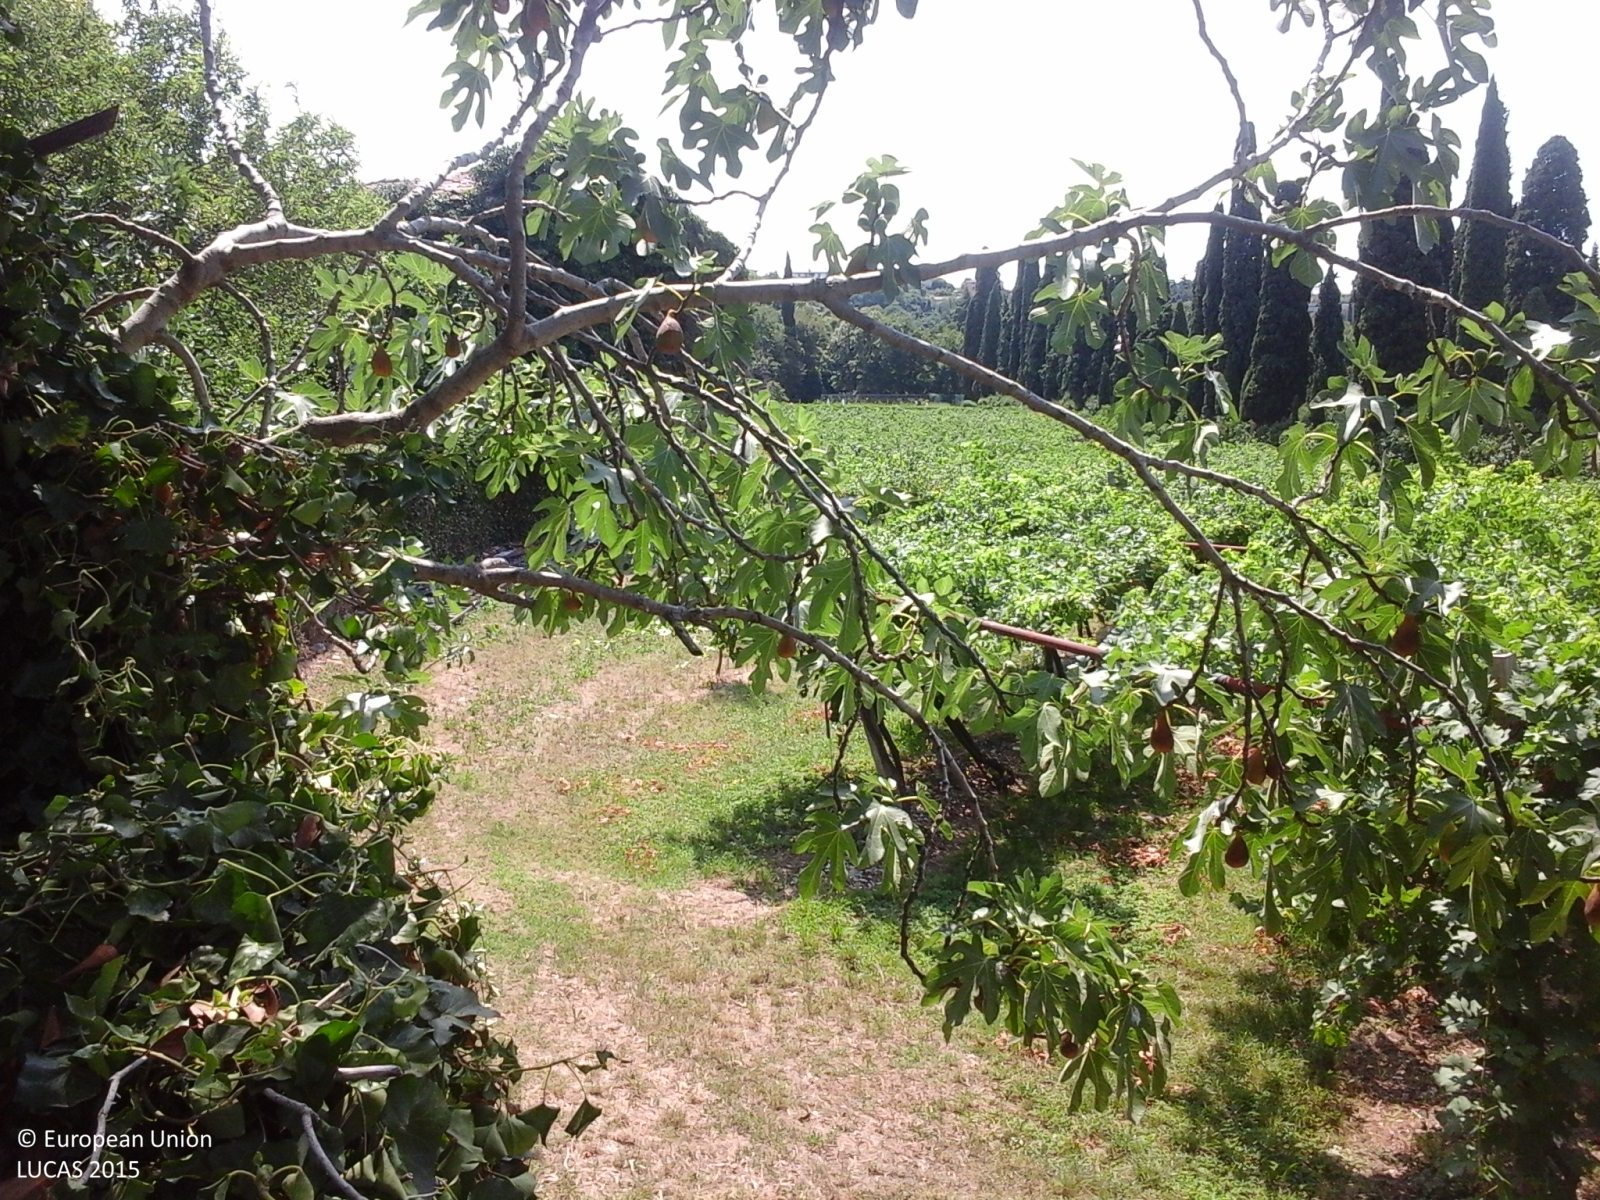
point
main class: Cropland
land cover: Vineyards
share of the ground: > 75 %
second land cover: Grassland without tree/shrub cover
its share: > 75 %
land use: Agriculture (excluding fallow land and kitchen gardens)
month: July
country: IT
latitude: 45.4813
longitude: 11.0345
